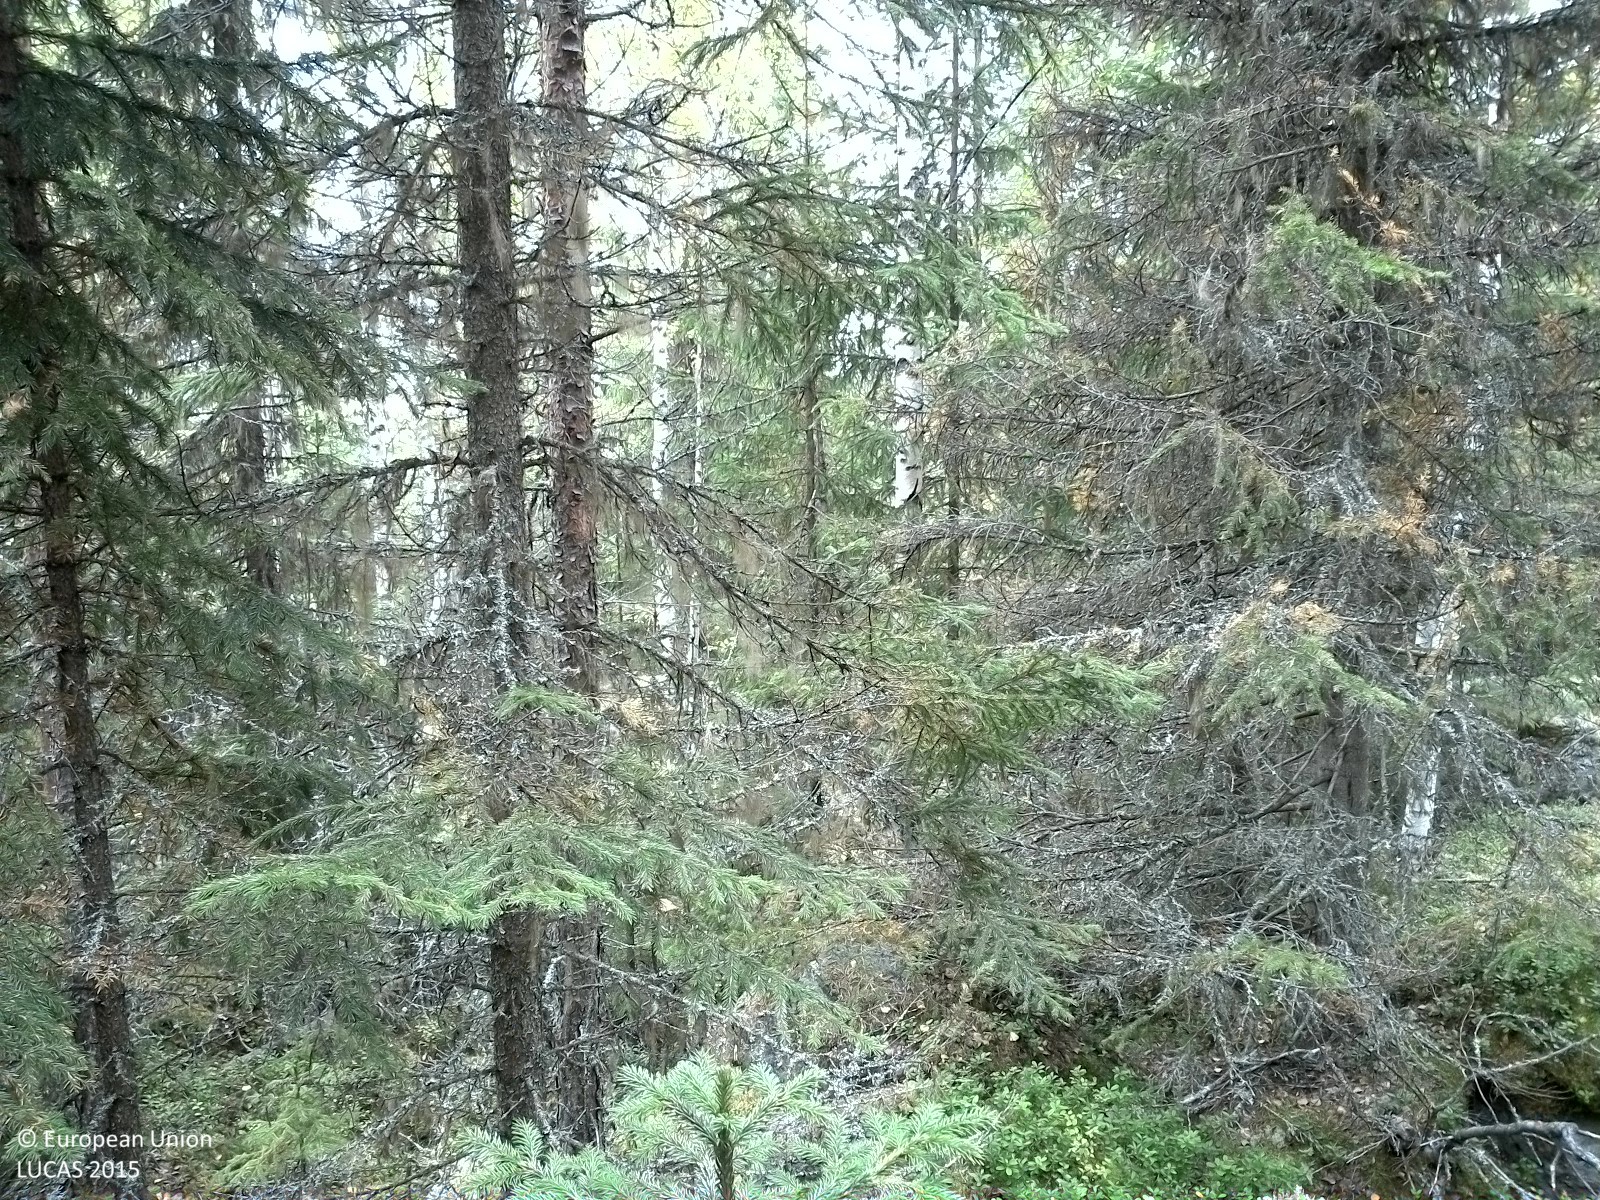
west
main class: Woodland
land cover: Spruce dominated mixed woodland
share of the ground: 50 - 75 %
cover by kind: coniferous forest trees 40 %, broadleaved forest trees 20 %, shrubs 20 %, lichens and mosses 20 %
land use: Forestry
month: September
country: SE
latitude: 62.4909
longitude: 16.4805
